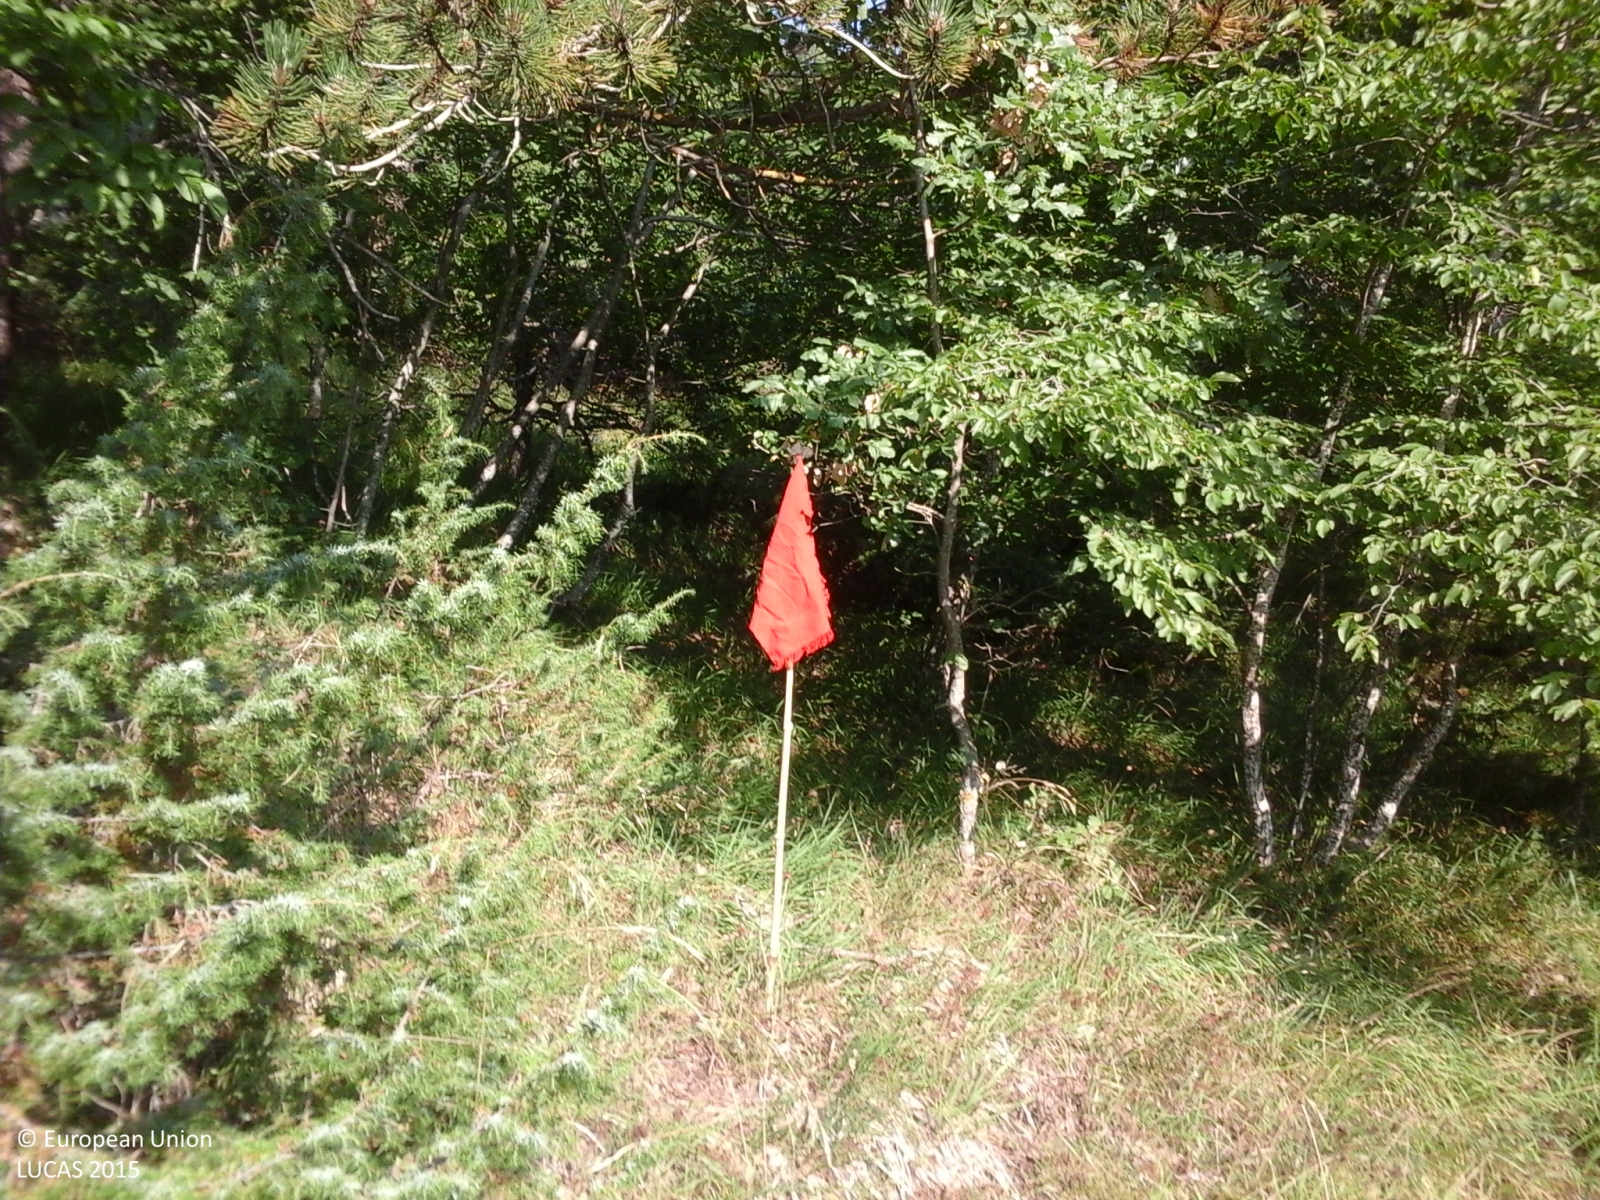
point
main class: Woodland
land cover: Pine dominated mixed woodland
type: coniferous forest of the mediterranean region
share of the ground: > 75 %
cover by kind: coniferous forest trees 75 %, broadleaved forest trees 25 %
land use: Forestry
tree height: > 5 m
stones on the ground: < 10 %
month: August
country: IT
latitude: 42.9118
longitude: 13.1634
